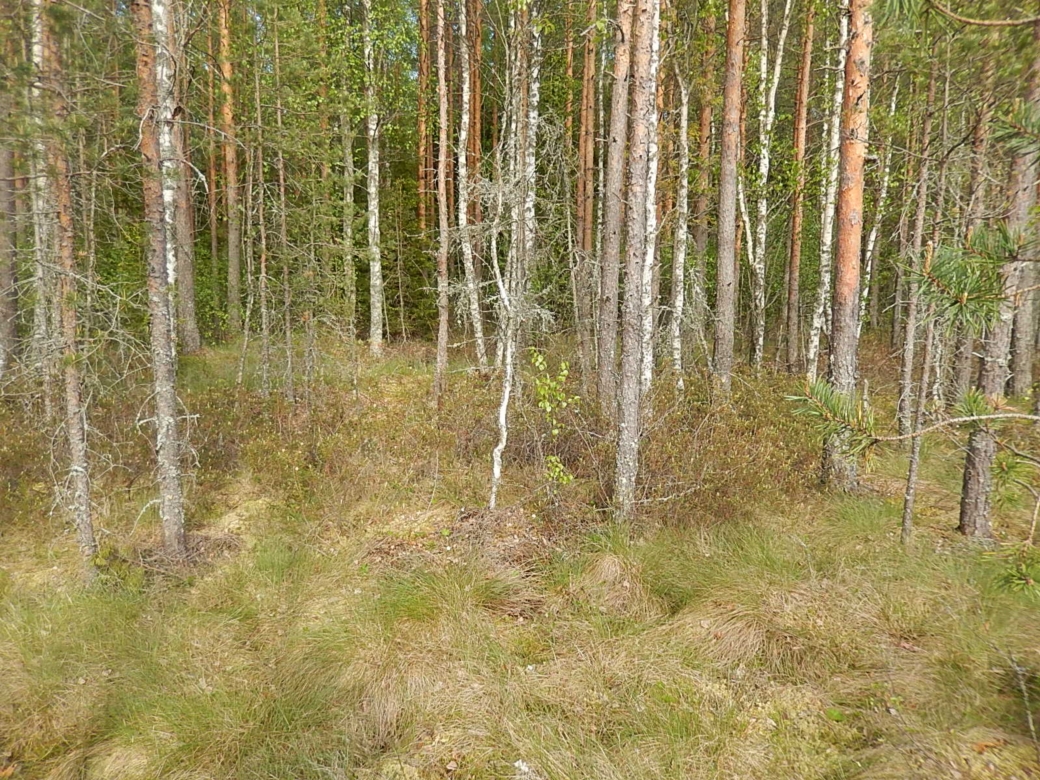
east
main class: Woodland
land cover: Pine dominated mixed woodland
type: boreal forest
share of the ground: > 75 %
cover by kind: coniferous forest trees 50 %, broadleaved forest trees 30 %, shrubs 10 %, herbaceous plants 10 %
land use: Forestry
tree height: > 5 m
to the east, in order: Pine dominated mixed woodland; Ditches and canals; Pine dominated mixed woodland; Ditches and canals; Pine dominated mixed woodland; Ditches and canals; Pine dominated mixed woodland; Ditches and canals; Other mixed woodland; Tracks; Pine dominated coniferous woodland
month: June
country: FI
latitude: 61.9480
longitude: 21.5418
